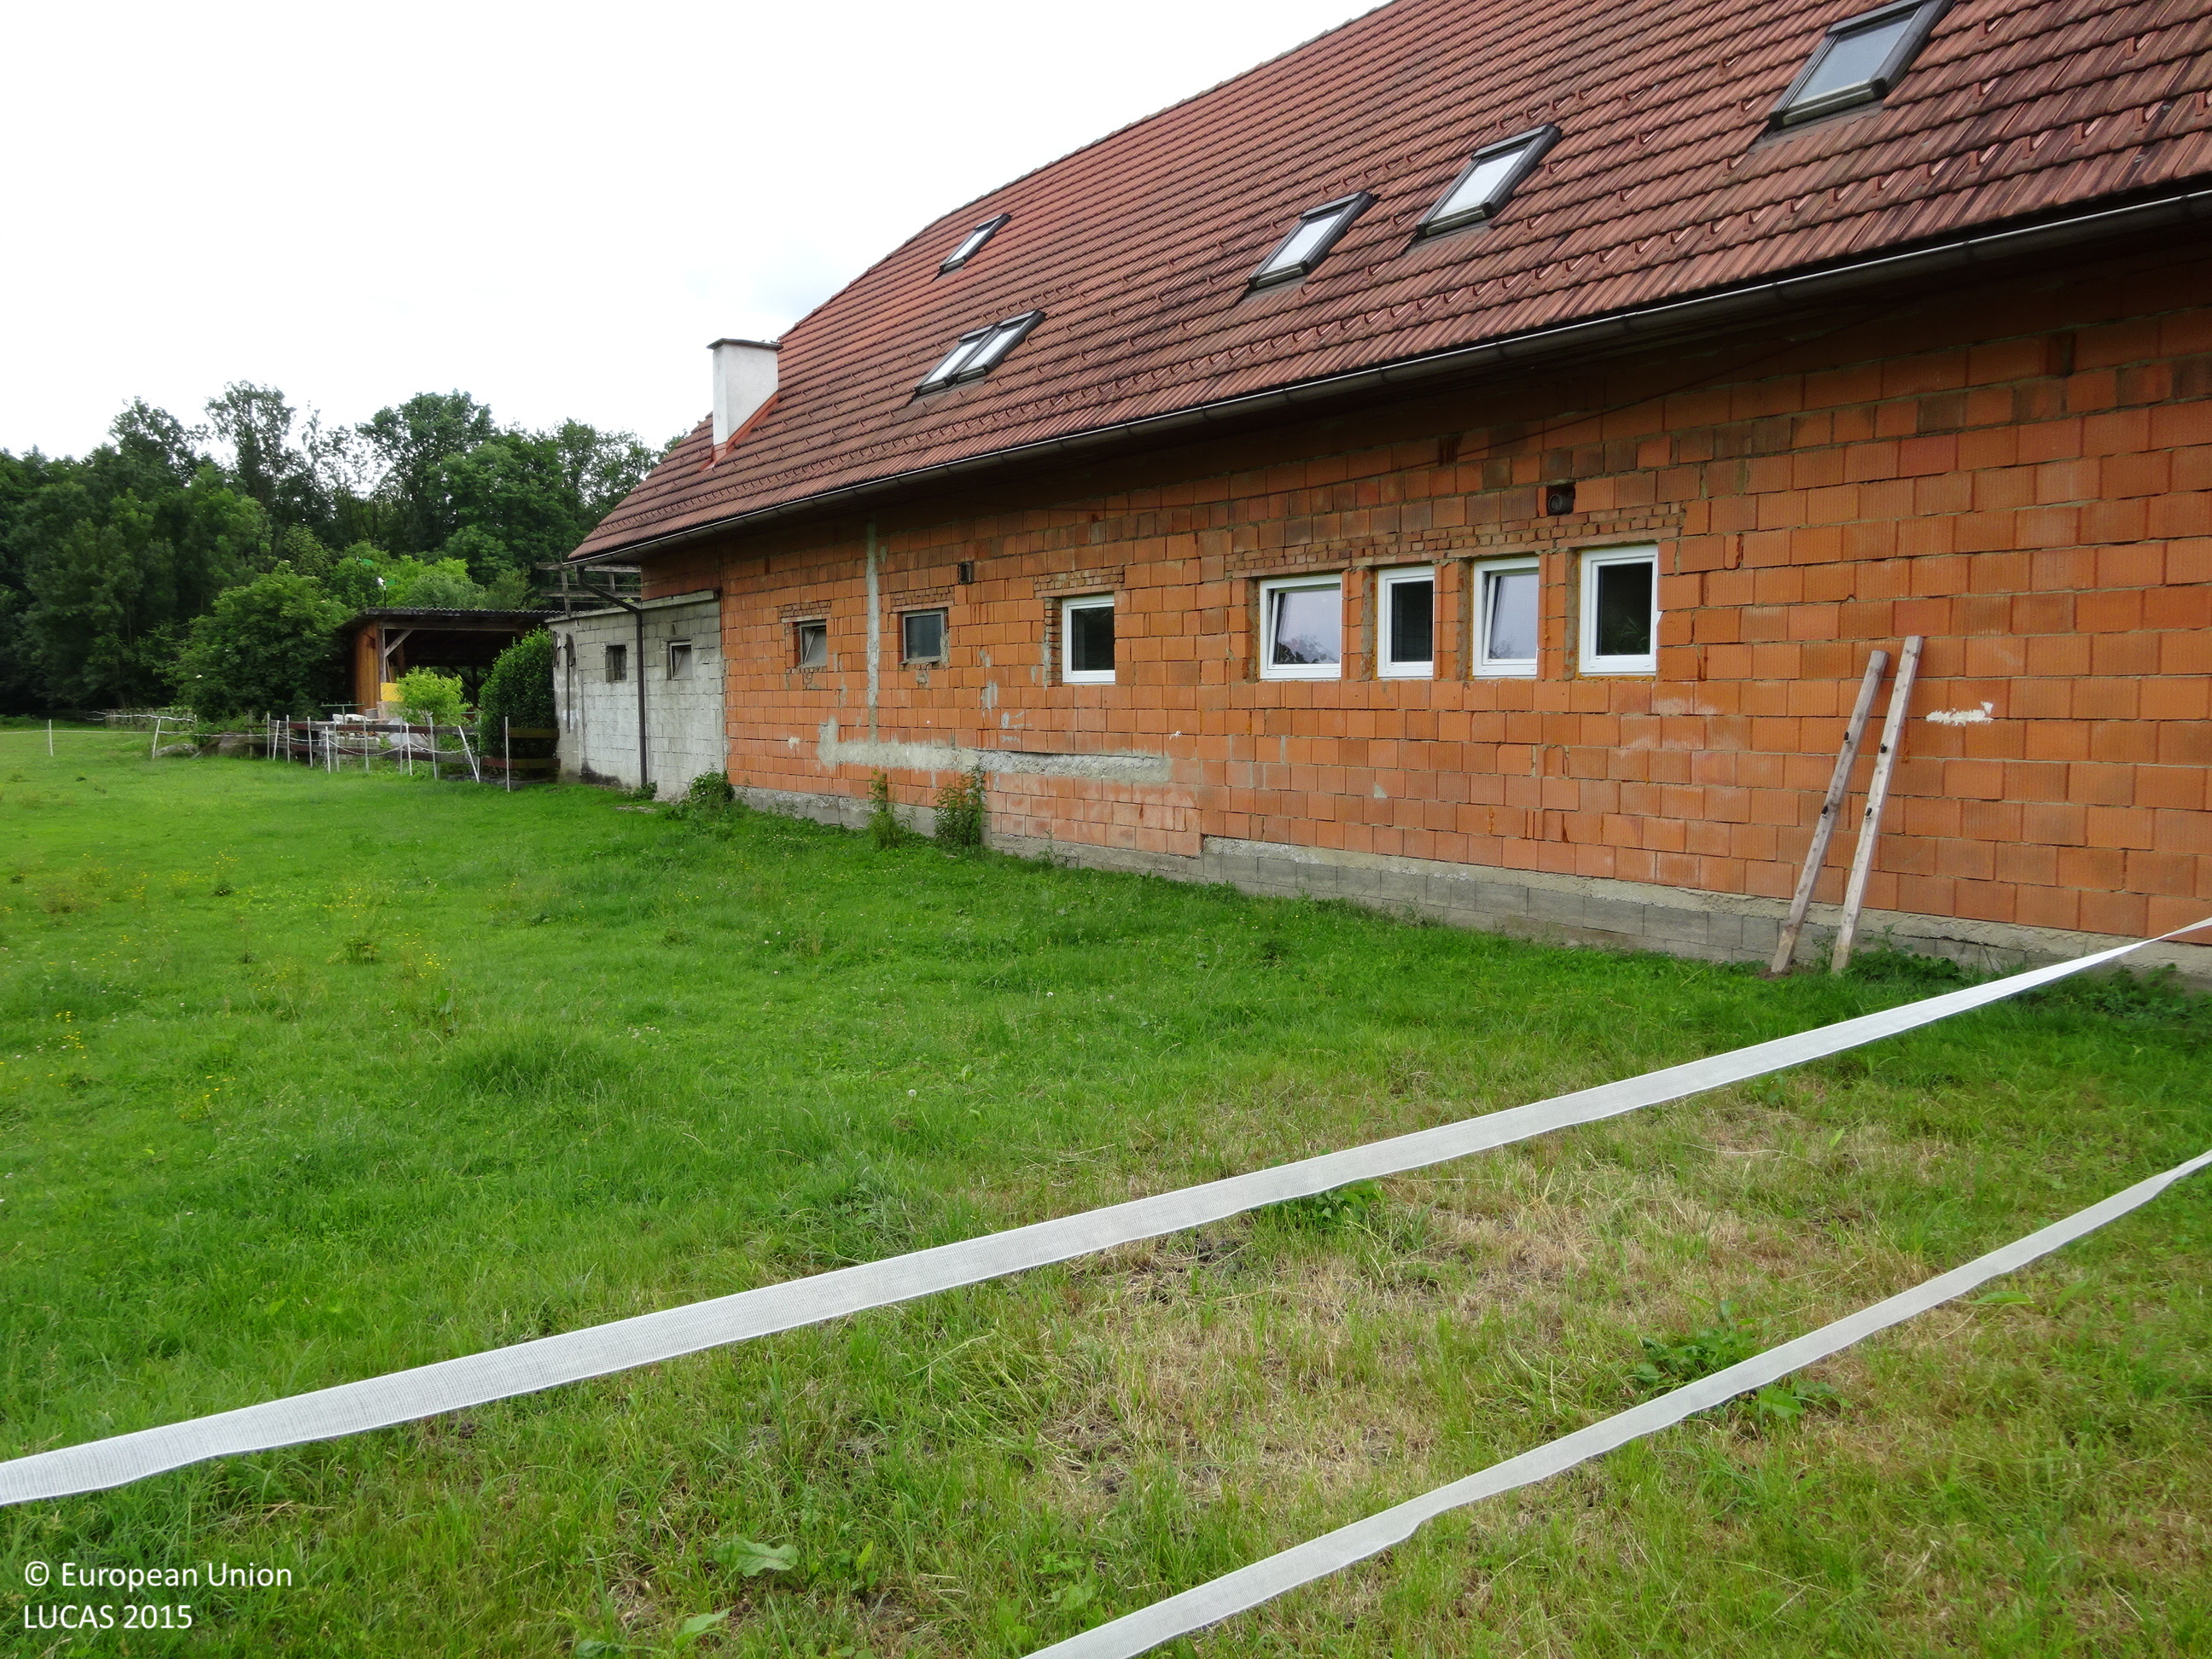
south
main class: Grassland
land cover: Grassland without tree/shrub cover
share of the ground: > 75 %
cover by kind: herbaceous plants 100 %
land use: Agriculture (excluding fallow land and kitchen gardens)
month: June
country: AT
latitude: 46.7273
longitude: 15.6128
